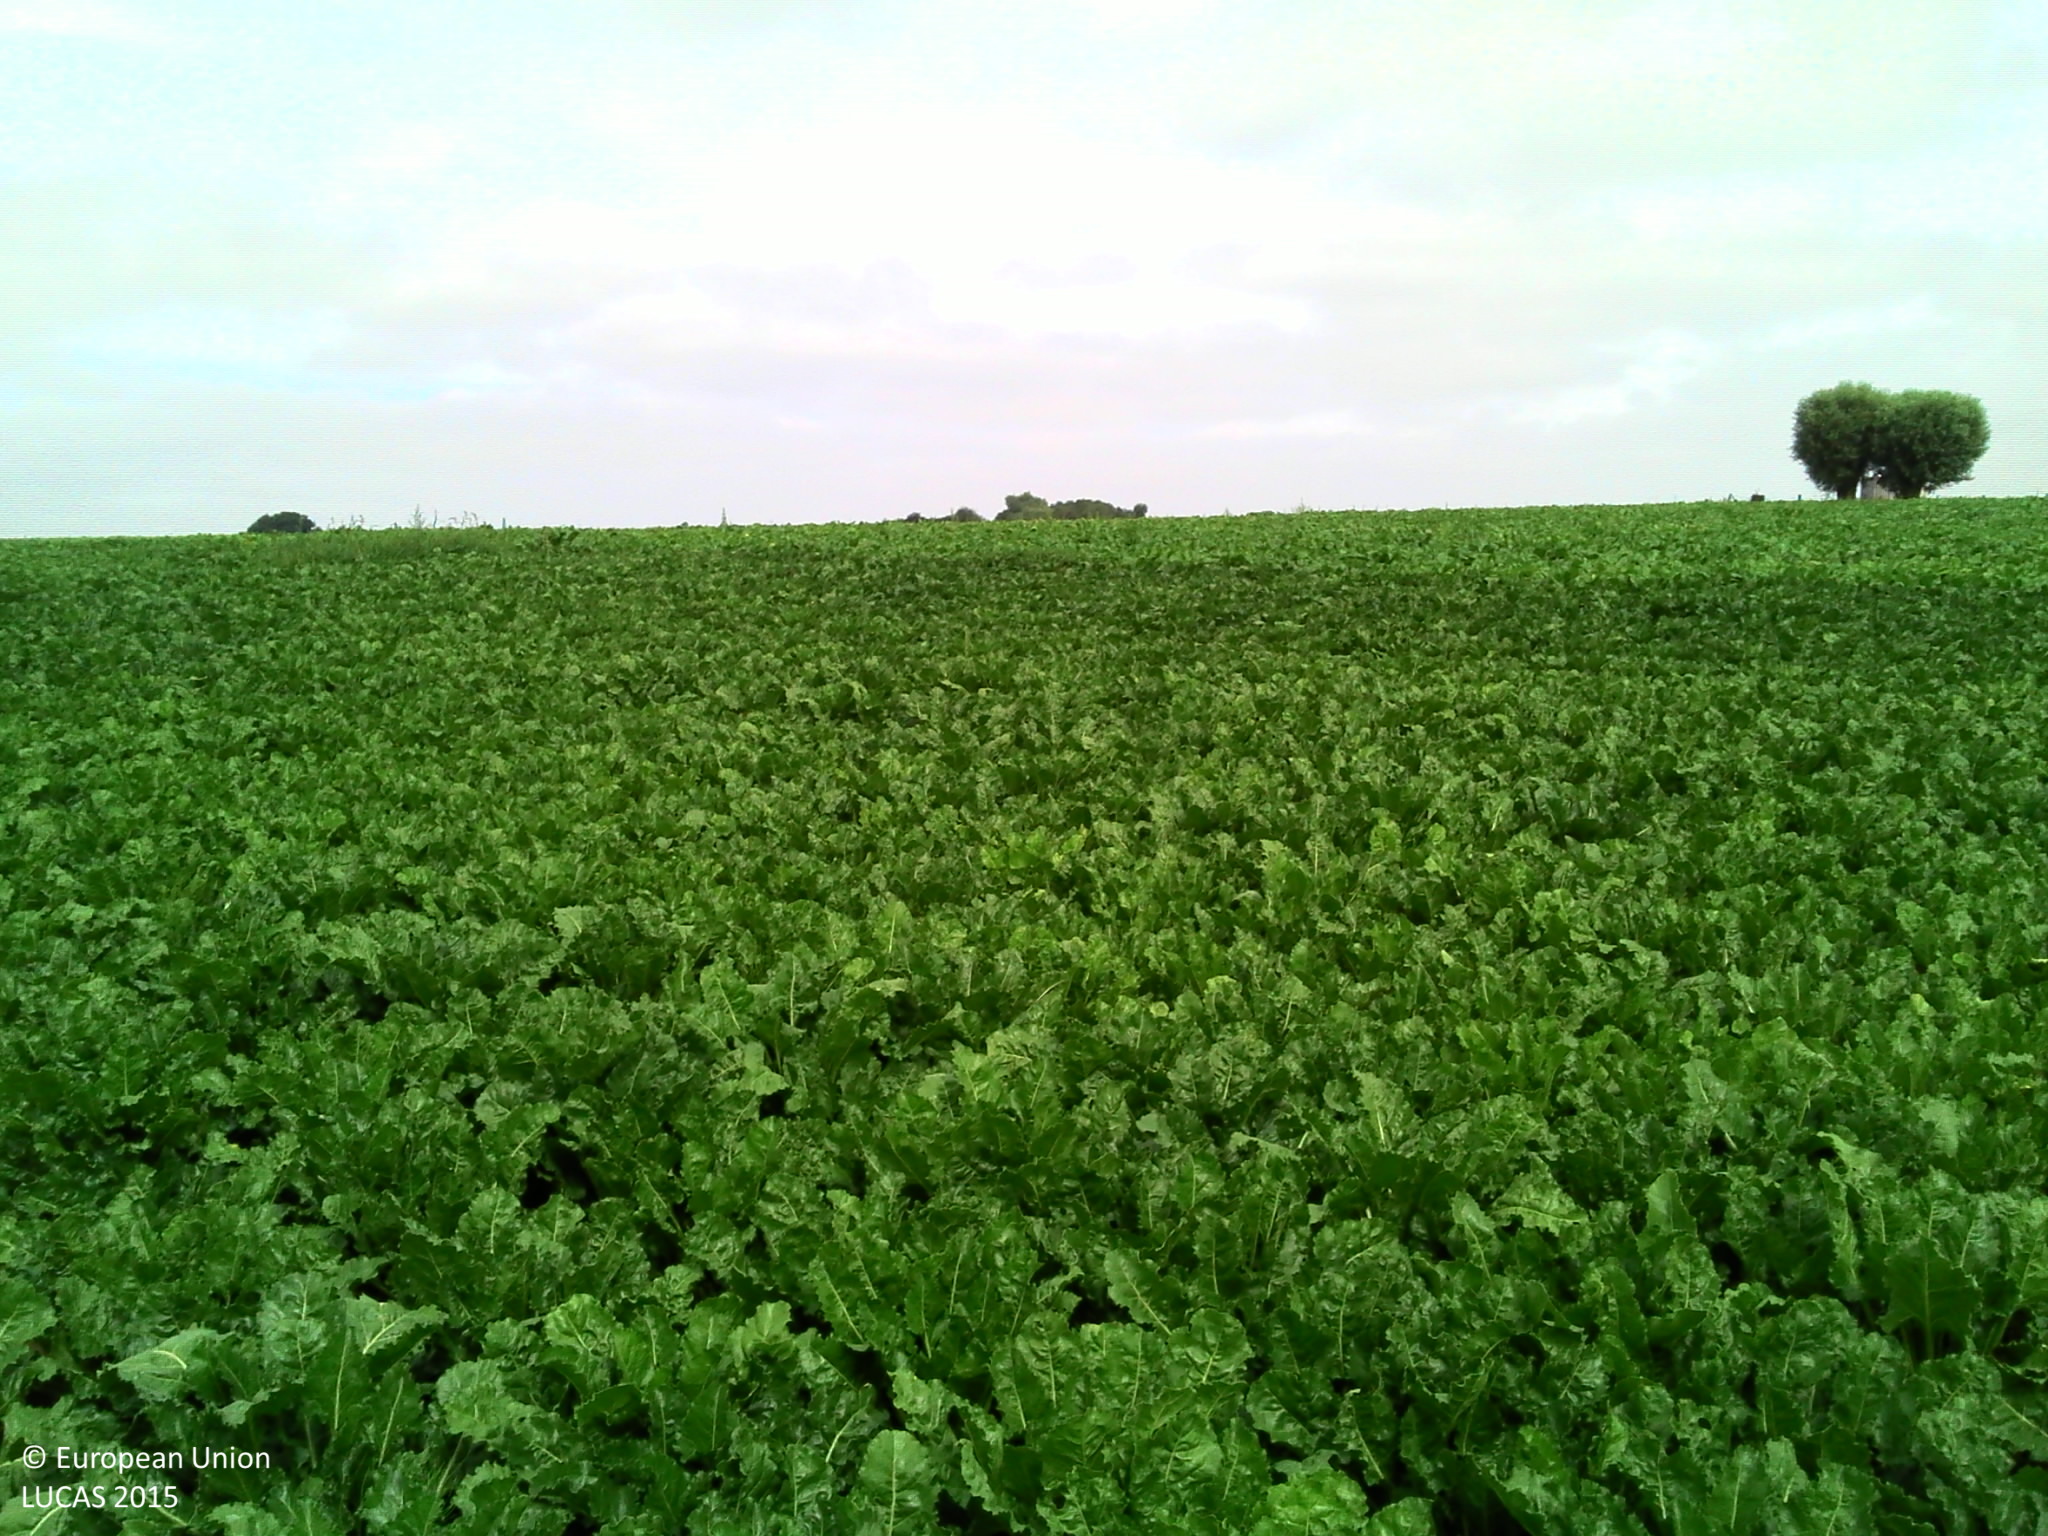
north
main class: Cropland
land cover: Sugar beet
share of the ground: > 75 %
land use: Agriculture (excluding fallow land and kitchen gardens)
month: August
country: BE
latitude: 50.7012
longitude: 3.8061
